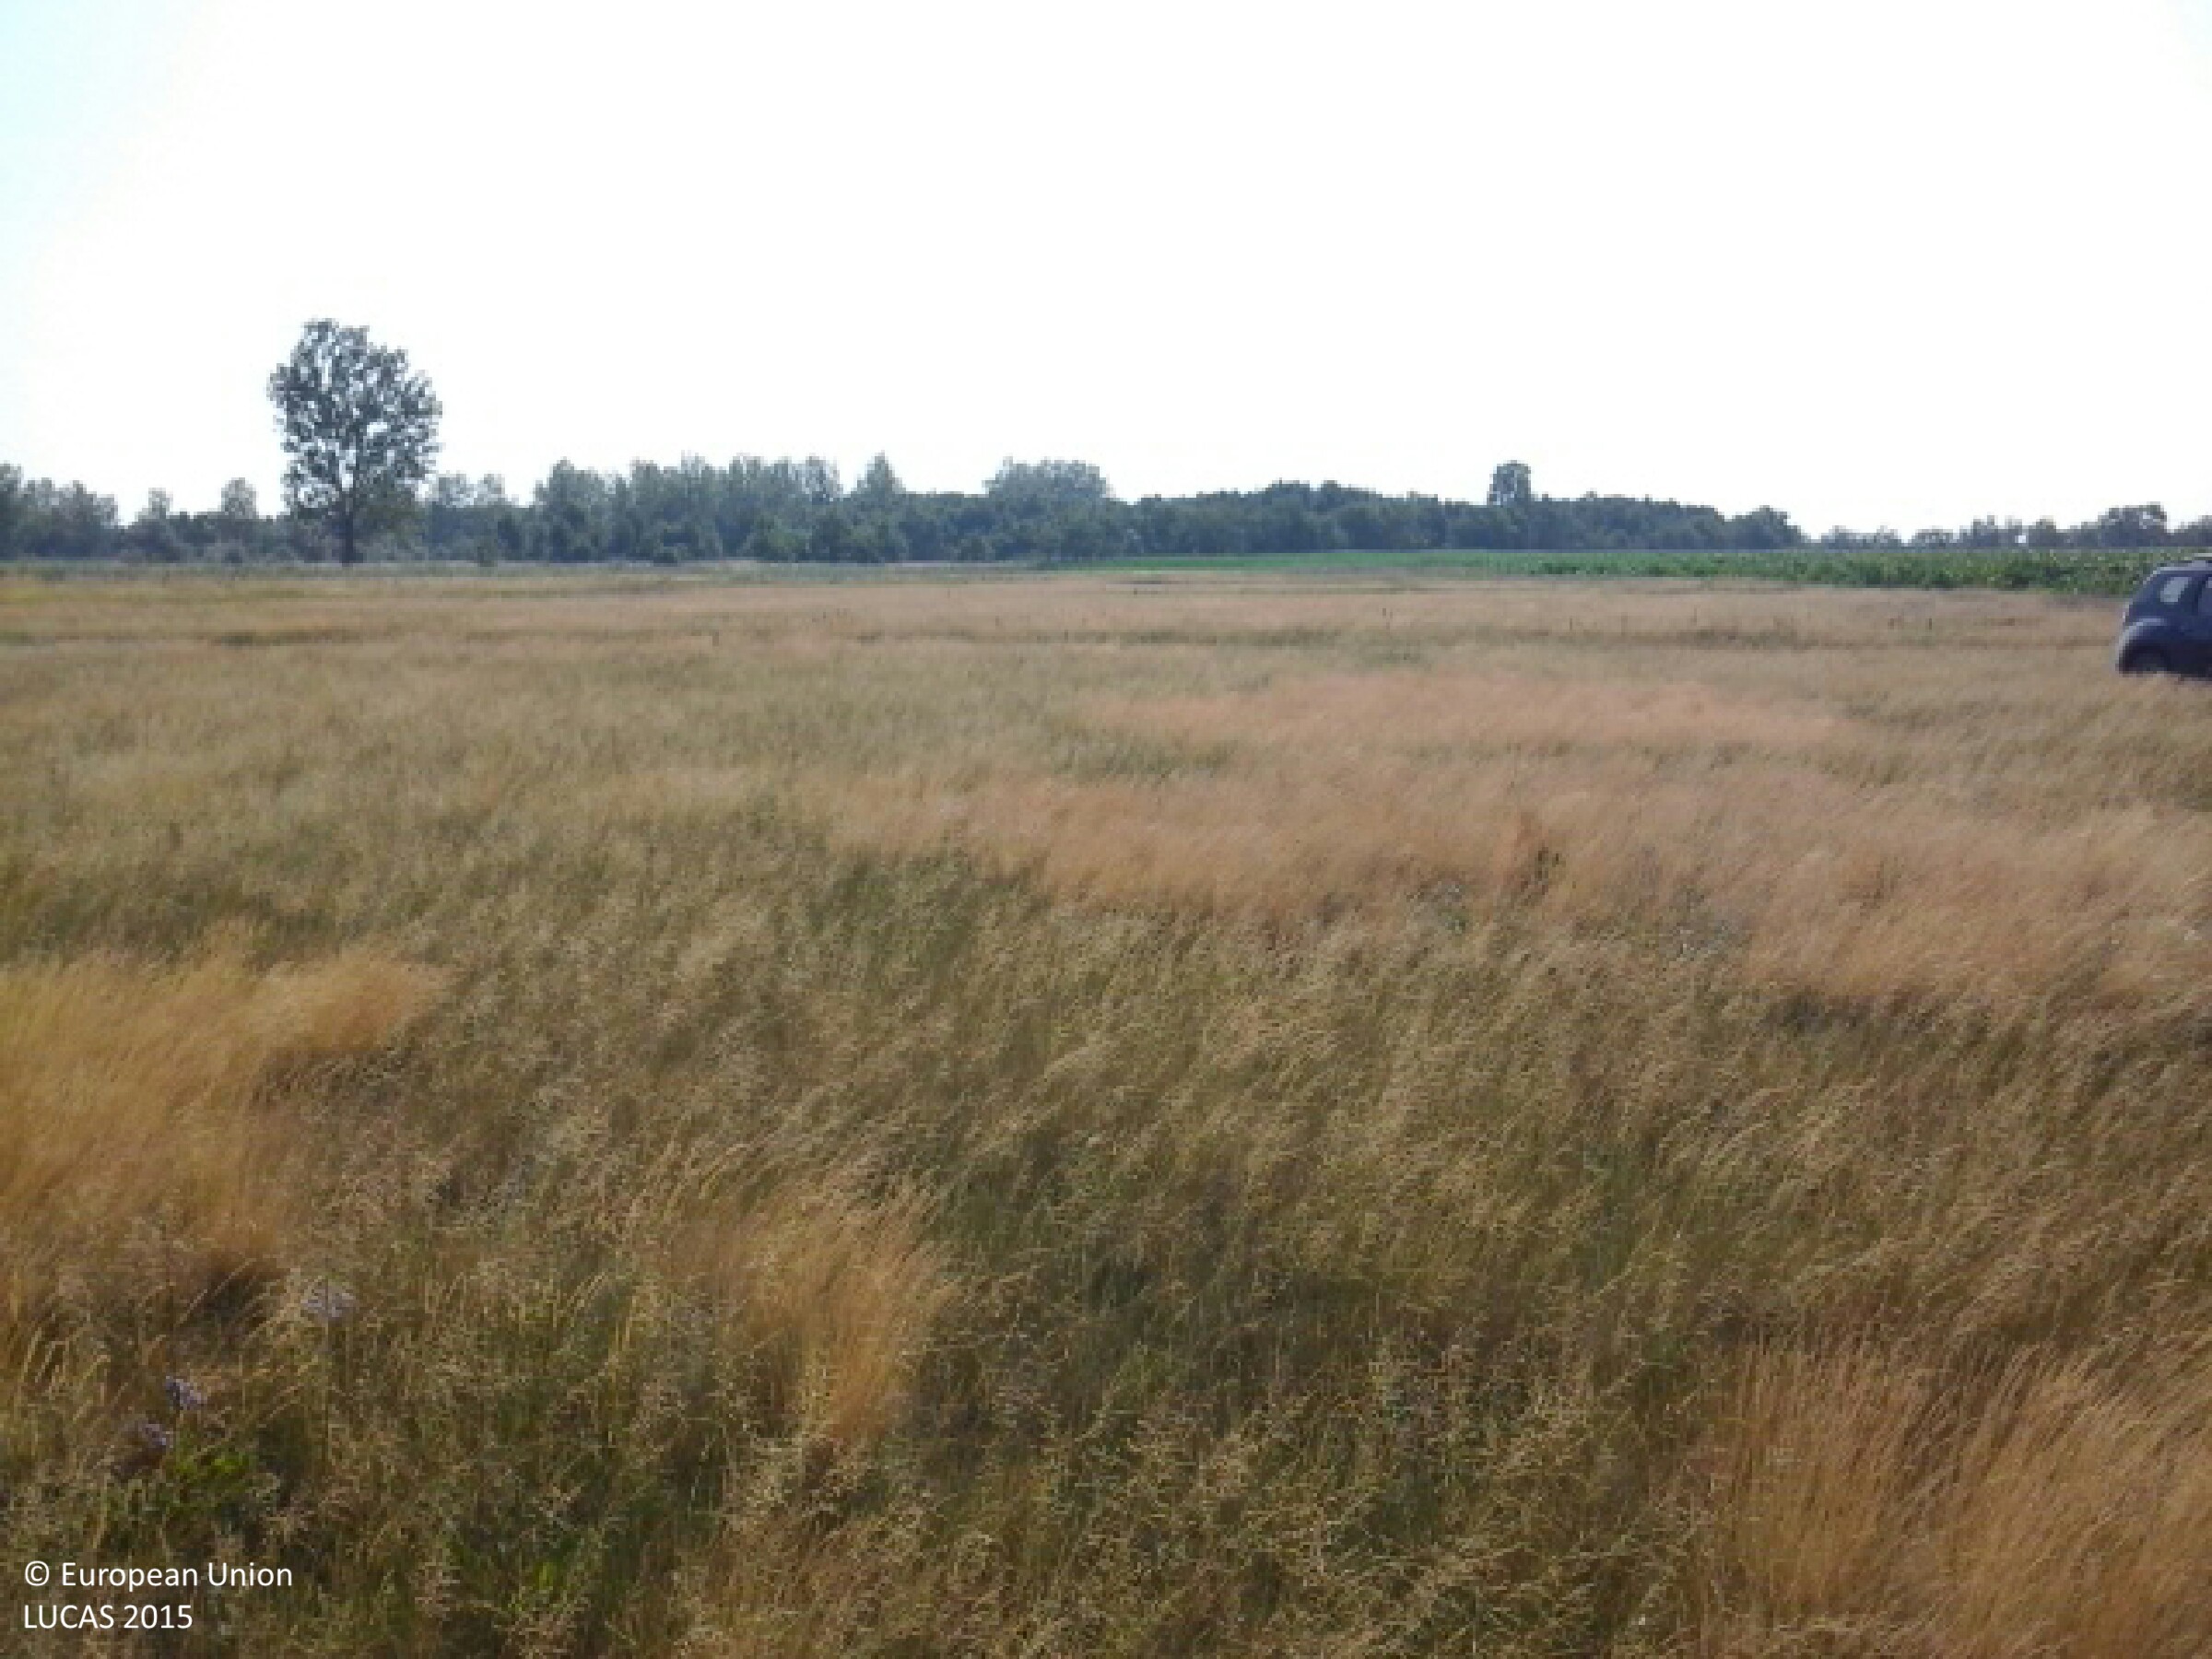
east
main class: Grassland
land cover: Grassland without tree/shrub cover
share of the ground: > 75 %
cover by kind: herbaceous plants 100 %
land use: Semi-natural and natural areas not in use
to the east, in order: Grassland without tree/shrub cover; Tracks; Grassland without tree/shrub cover; Ditches and canals; Grass margins; Paved roads, cycling and walking lanes; Grass margins; Ditches and canals; Grassland without tree/shrub cover
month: June
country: HU
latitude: 48.0007
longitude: 21.5045
